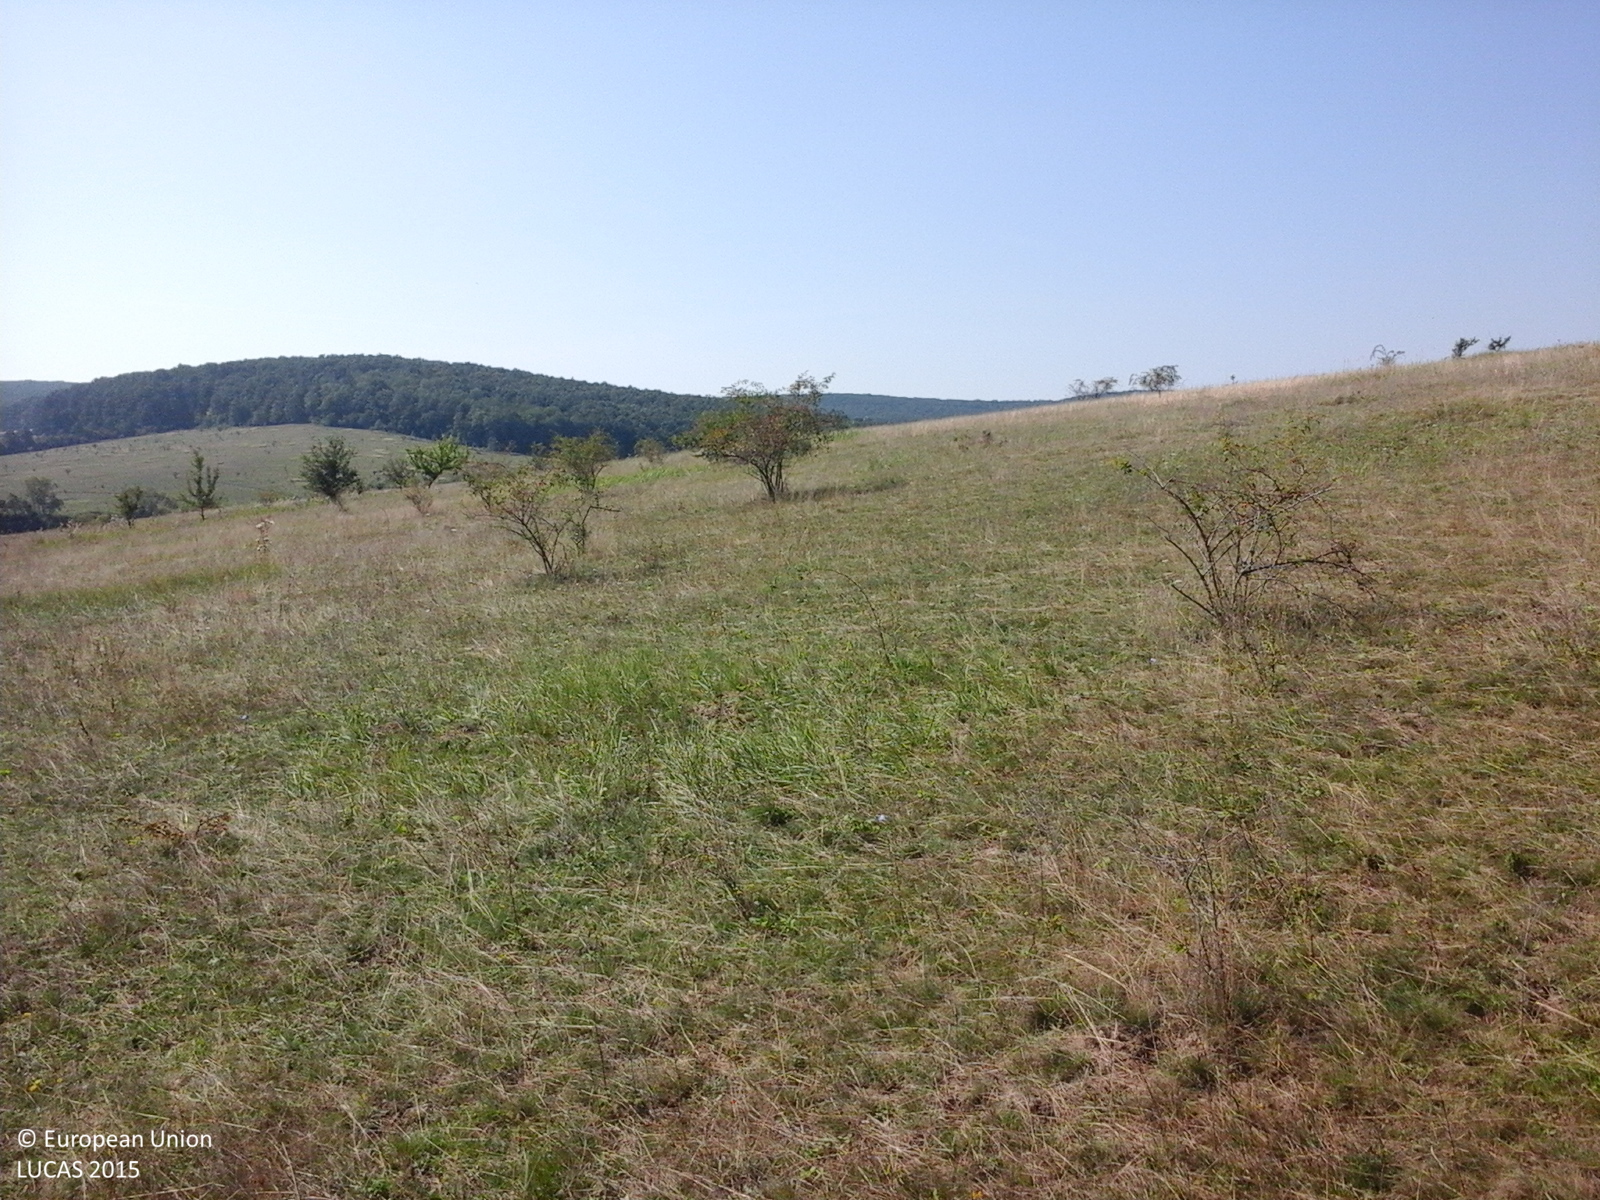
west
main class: Grassland
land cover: Grassland with sparse tree/shrub cover
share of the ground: > 75 %
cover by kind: herbaceous plants 90 %, broadleaved forest trees 5 %, shrubs 5 %
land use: Agriculture (excluding fallow land and kitchen gardens)
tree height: < 5 m
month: September
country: RO
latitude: 47.3222
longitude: 22.6944
